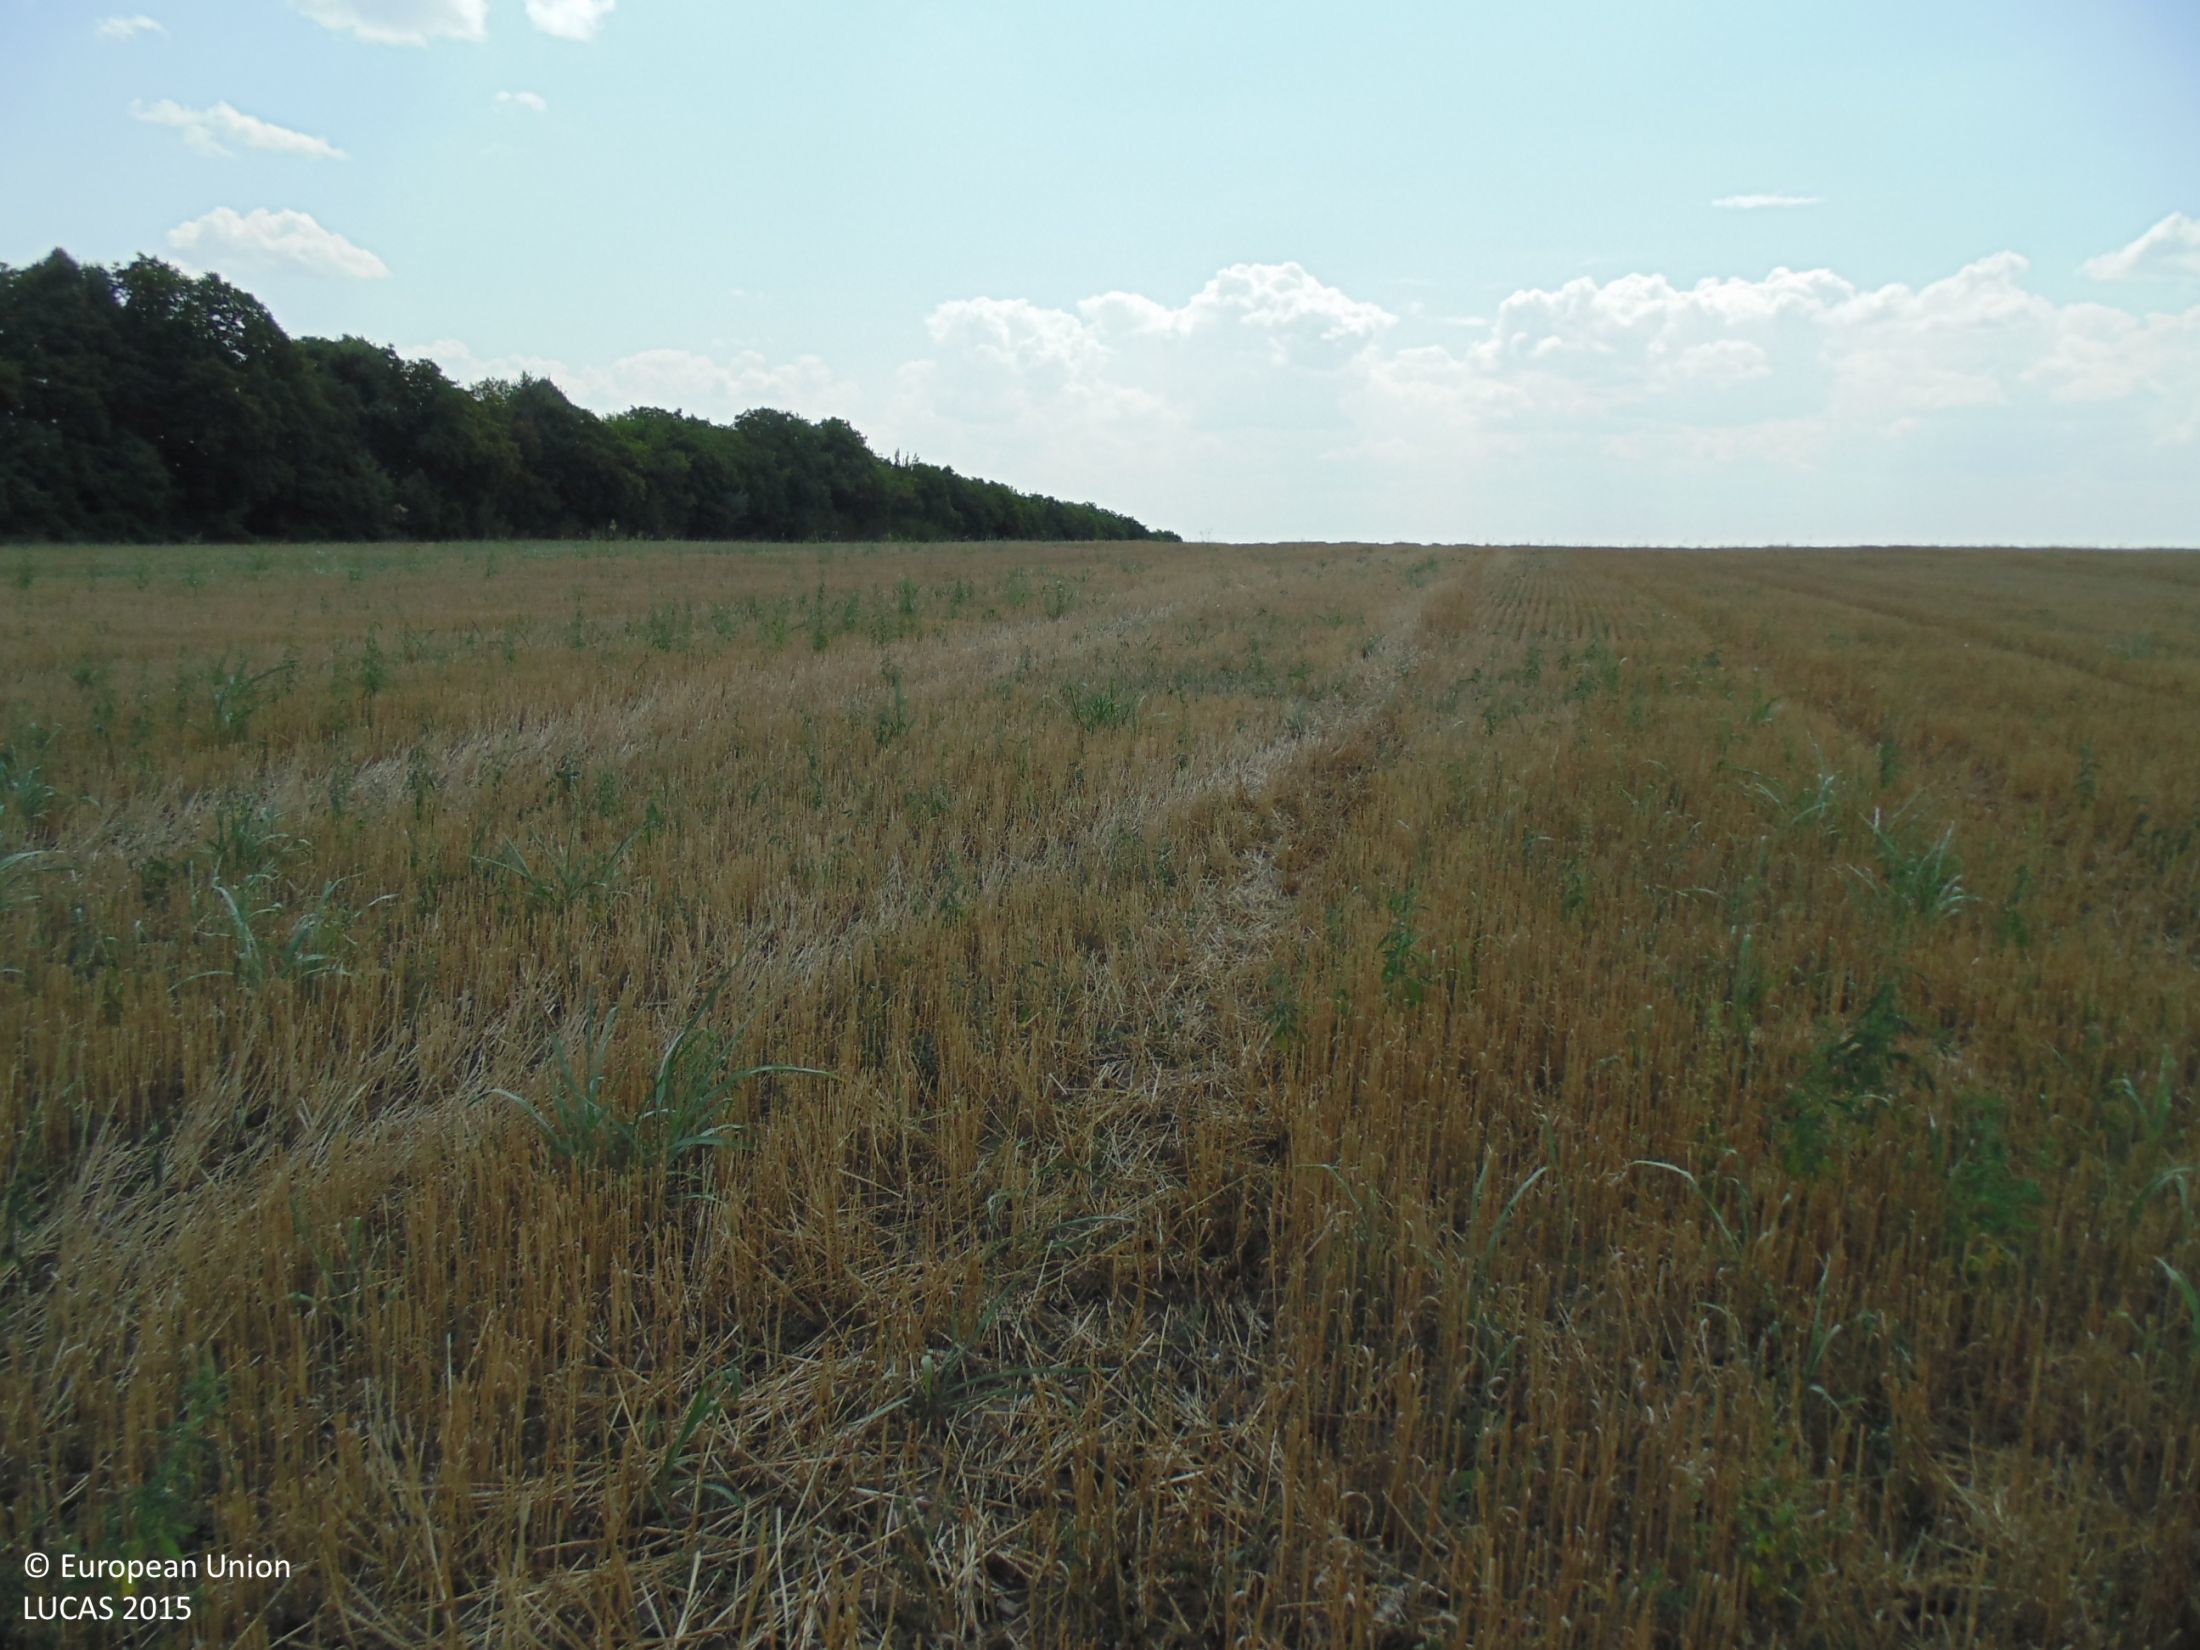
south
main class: Cropland
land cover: Common wheat
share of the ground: > 75 %
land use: Agriculture (excluding fallow land and kitchen gardens)
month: August
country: BG
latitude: 43.7771
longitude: 27.5679
